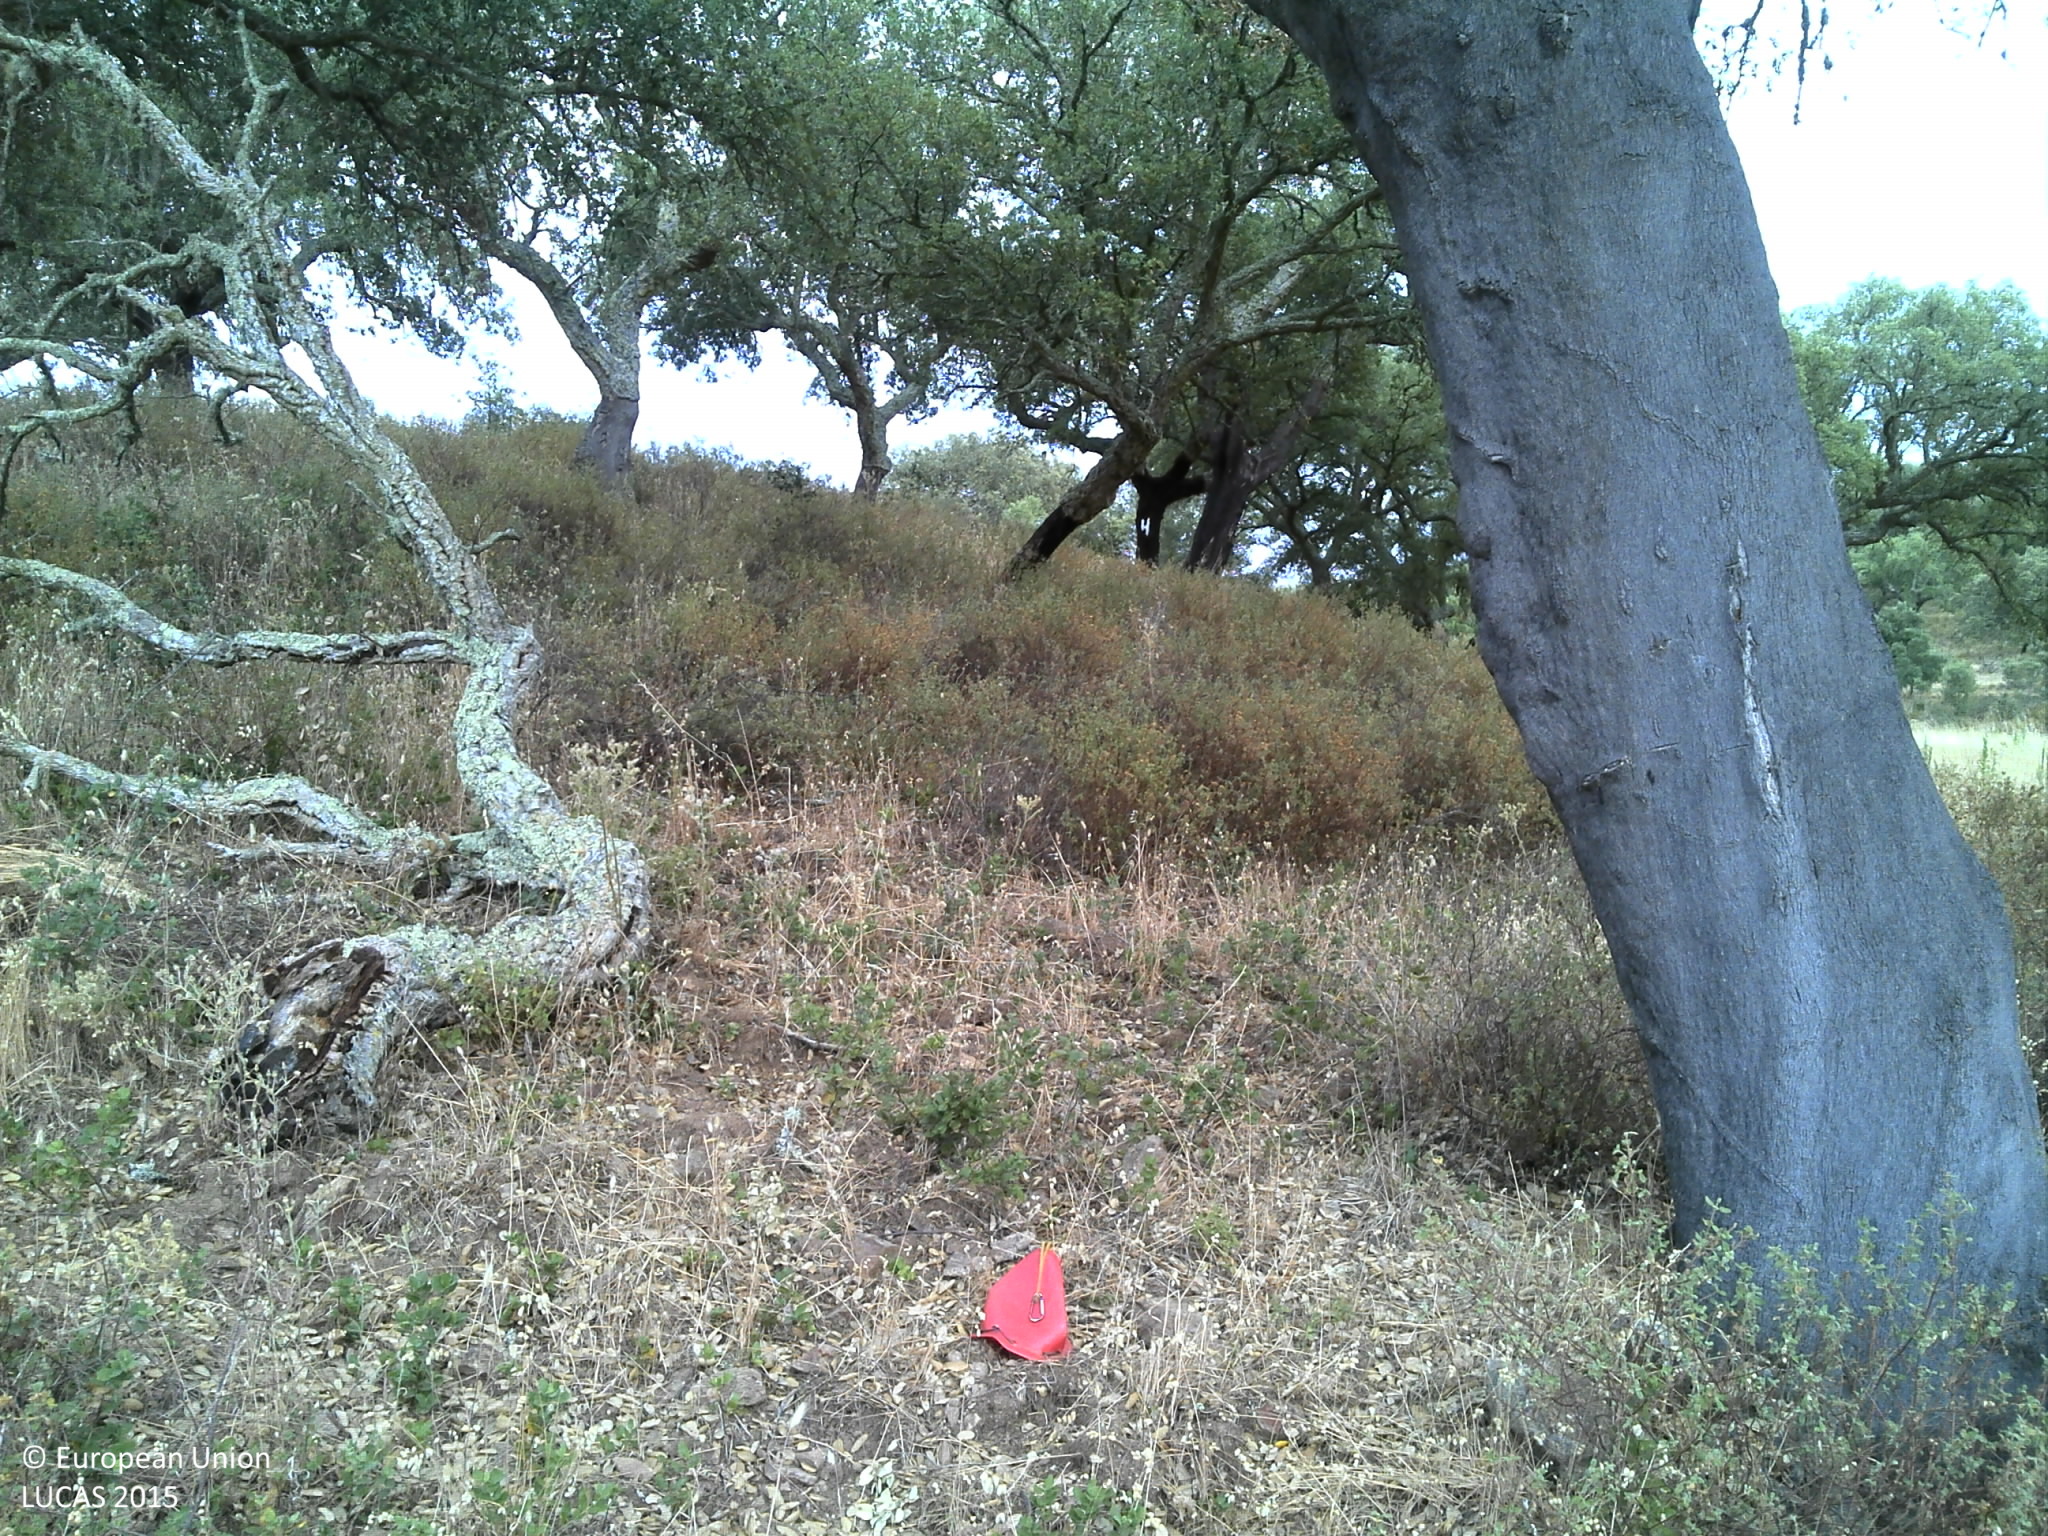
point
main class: Woodland
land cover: Broadleaved woodland
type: broadleaved evergreen forest
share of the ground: 25 - 50 %
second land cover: Grassland without tree/shrub cover
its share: 25 - 50 %
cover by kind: unconsolidated bare surface 35 %, herbaceous plants 30 %, broadleaved forest trees 25 %, shrubs 10 %
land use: Forestry
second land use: Agriculture (excluding fallow land and kitchen gardens)
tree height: > 5 m
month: June
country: PT
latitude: 38.3864
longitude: -7.7896
